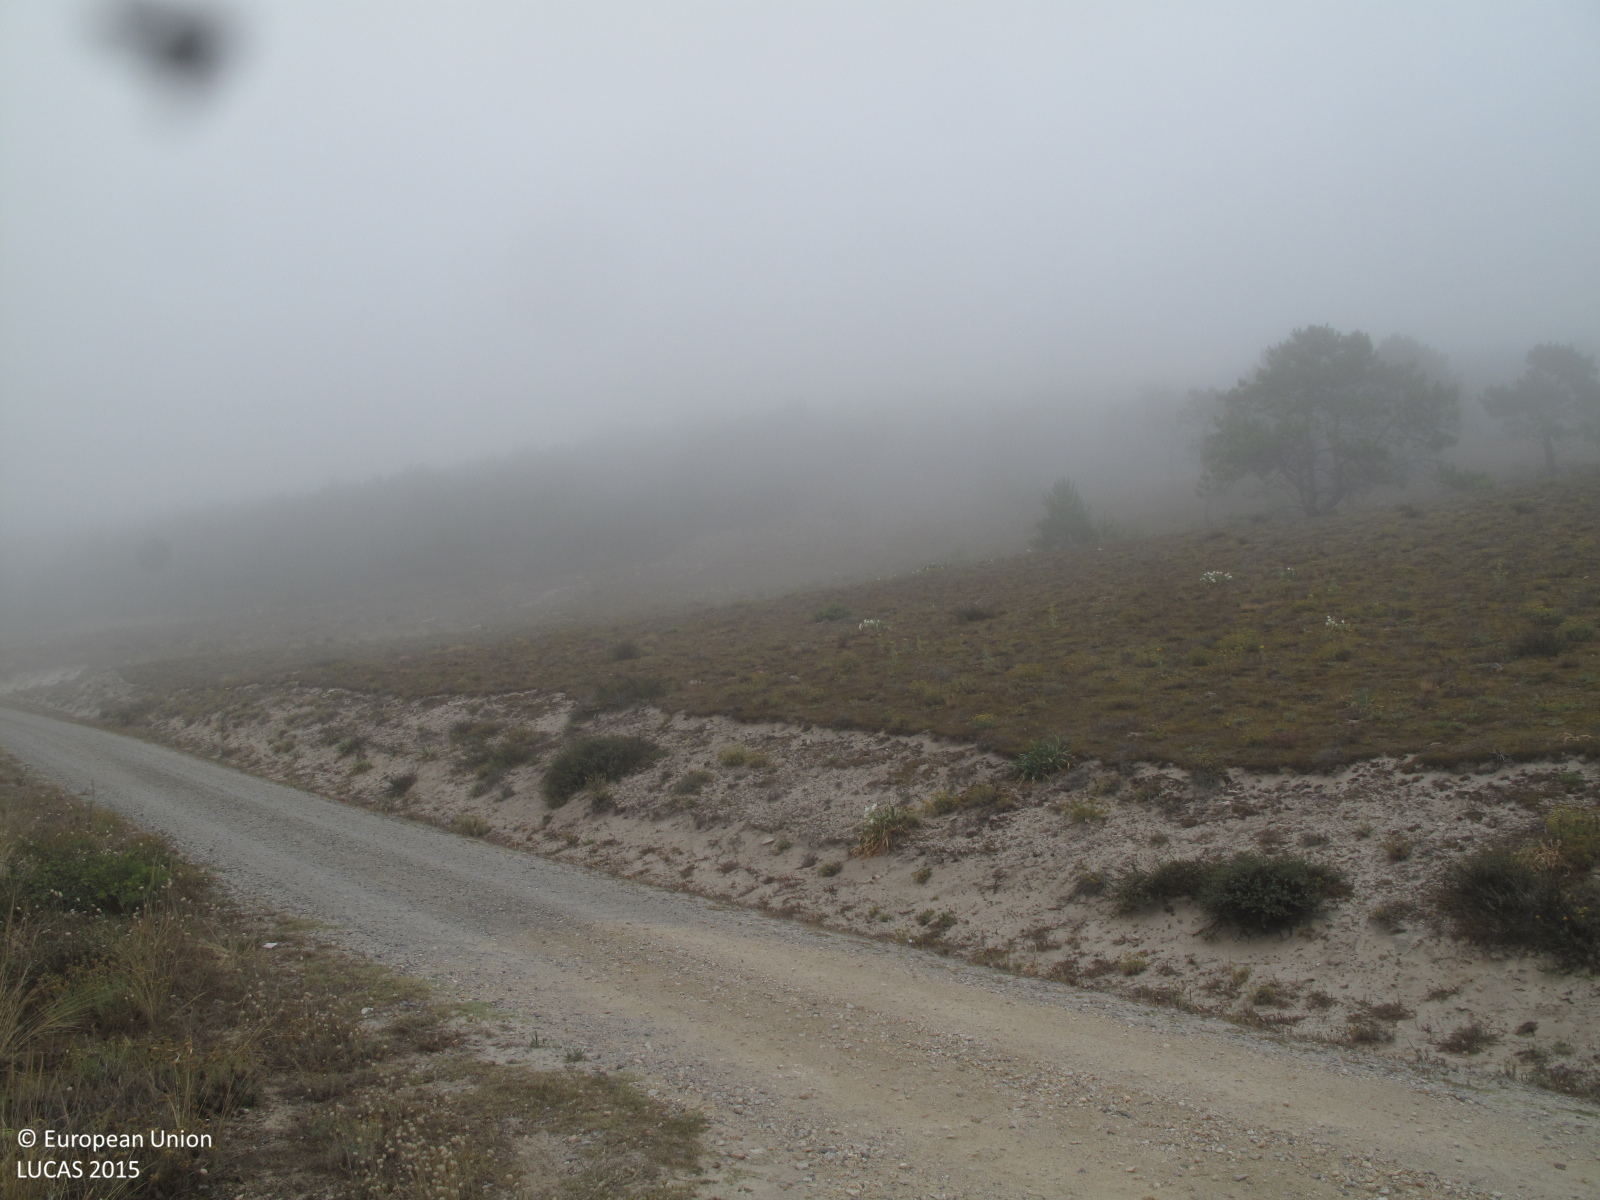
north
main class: Grassland
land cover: Grassland without tree/shrub cover
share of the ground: > 75 %
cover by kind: herbaceous plants 45 %, lichens and mosses 30 %, unconsolidated bare surface 20 %, shrubs 5 %
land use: Semi-natural and natural areas not in use
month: July
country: ES
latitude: 43.0069
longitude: -9.2559
